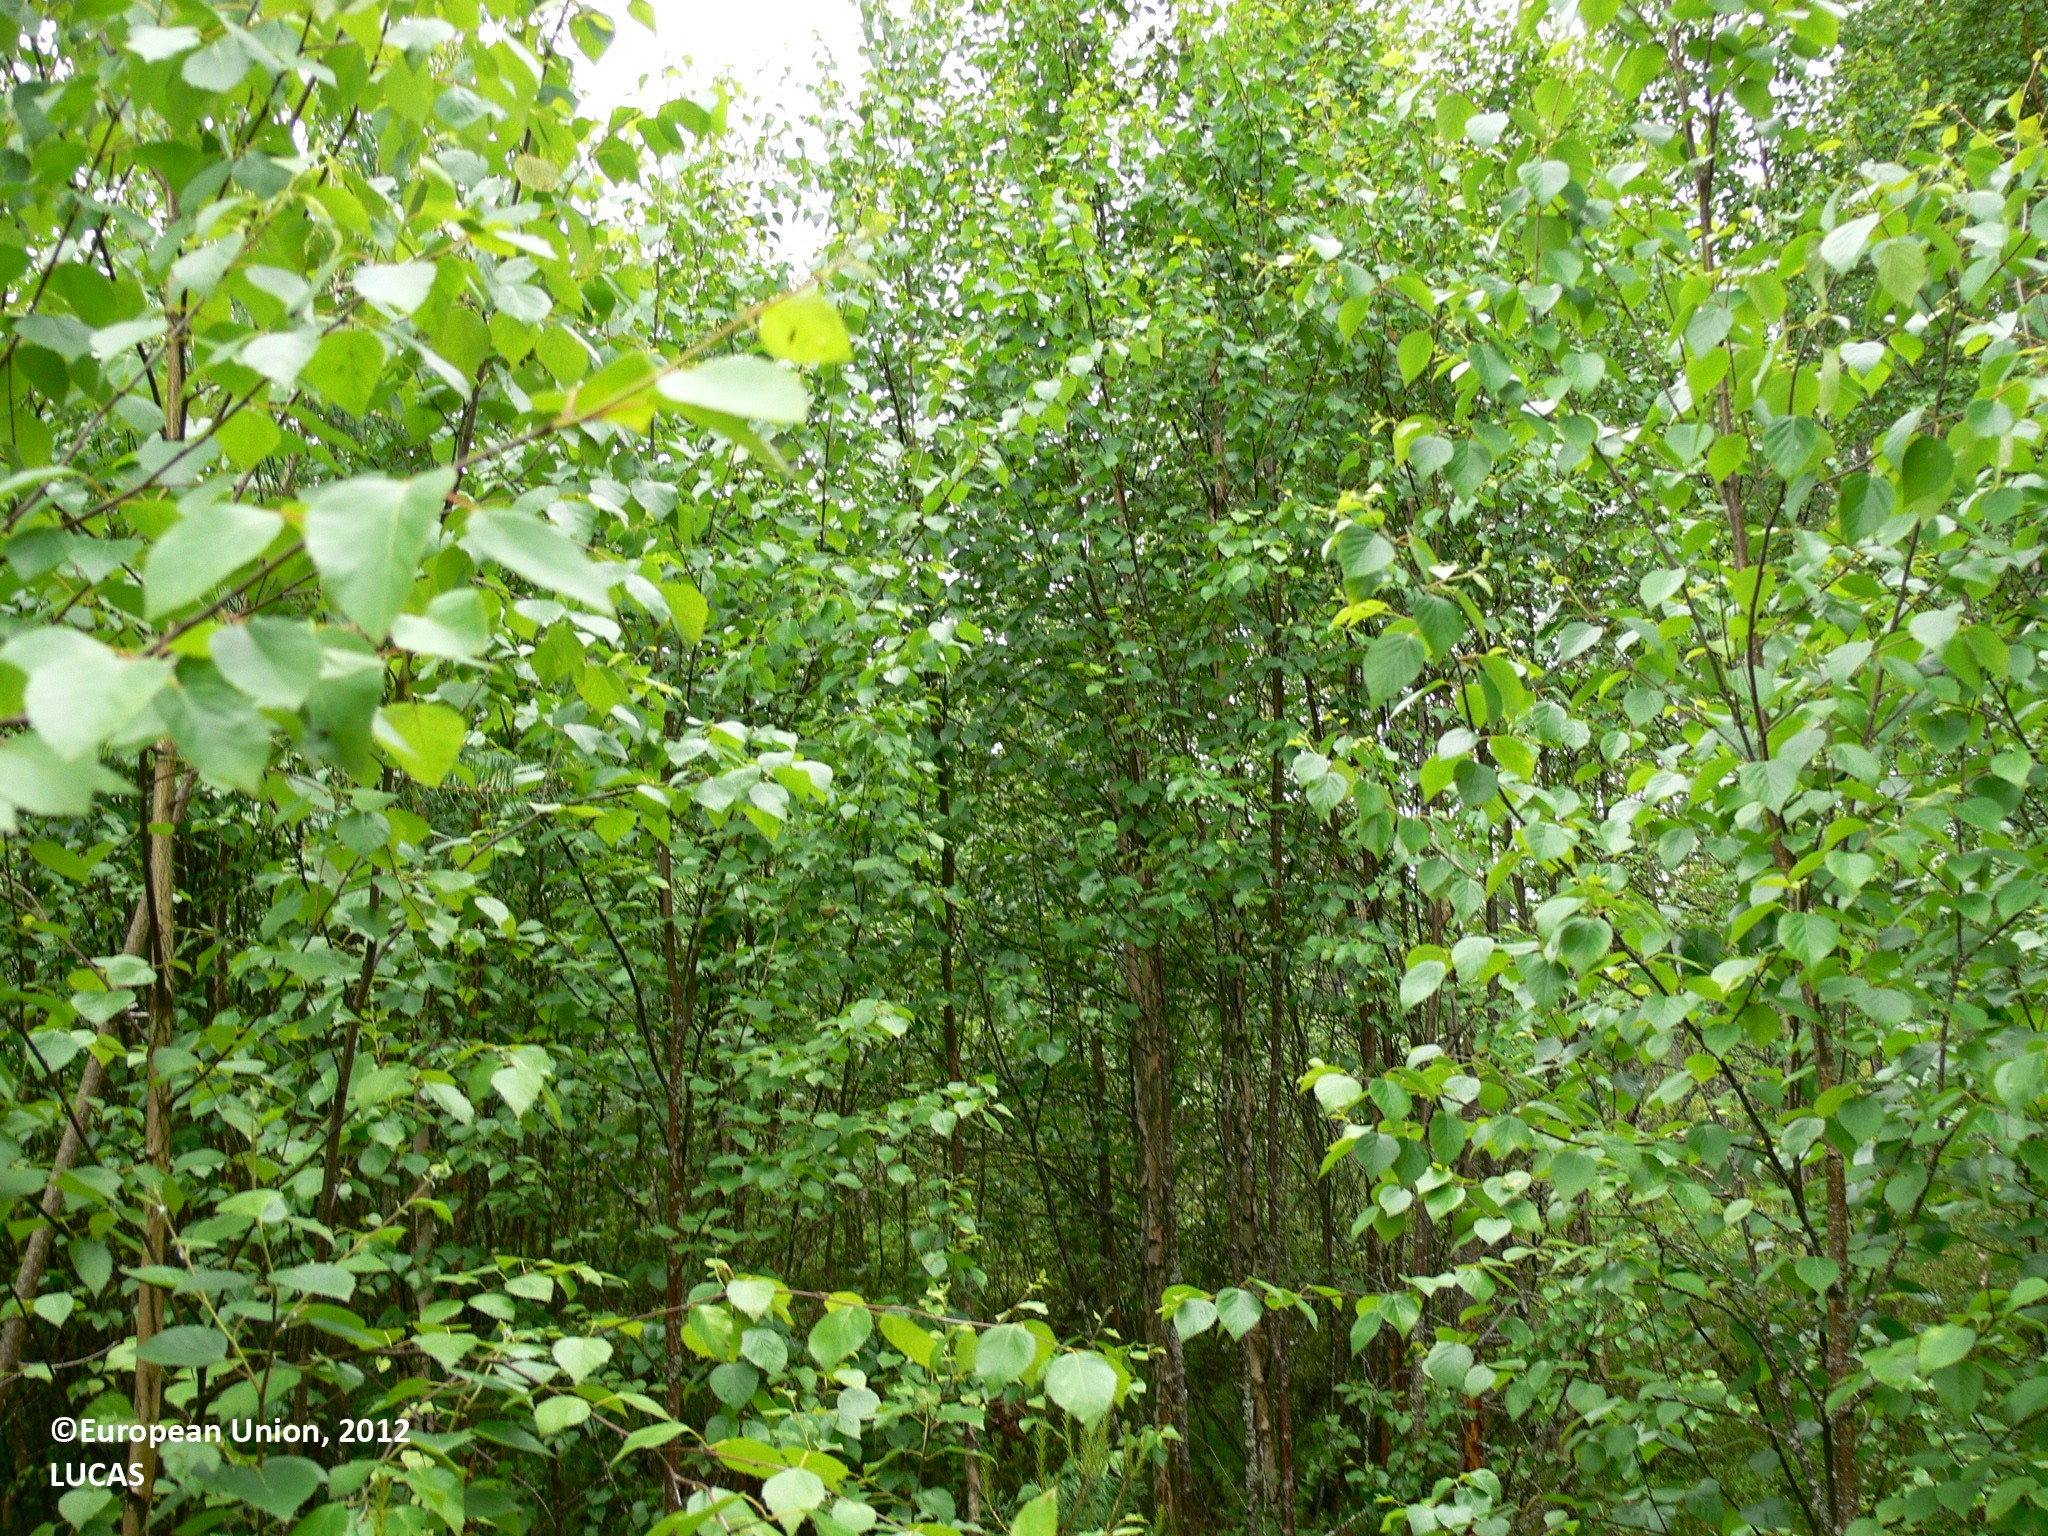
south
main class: Woodland
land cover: Pine dominated mixed woodland
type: boreal forest
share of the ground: 50 - 75 %
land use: Forestry
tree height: > 5 m
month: June
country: FI
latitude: 62.9323
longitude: 29.4374
